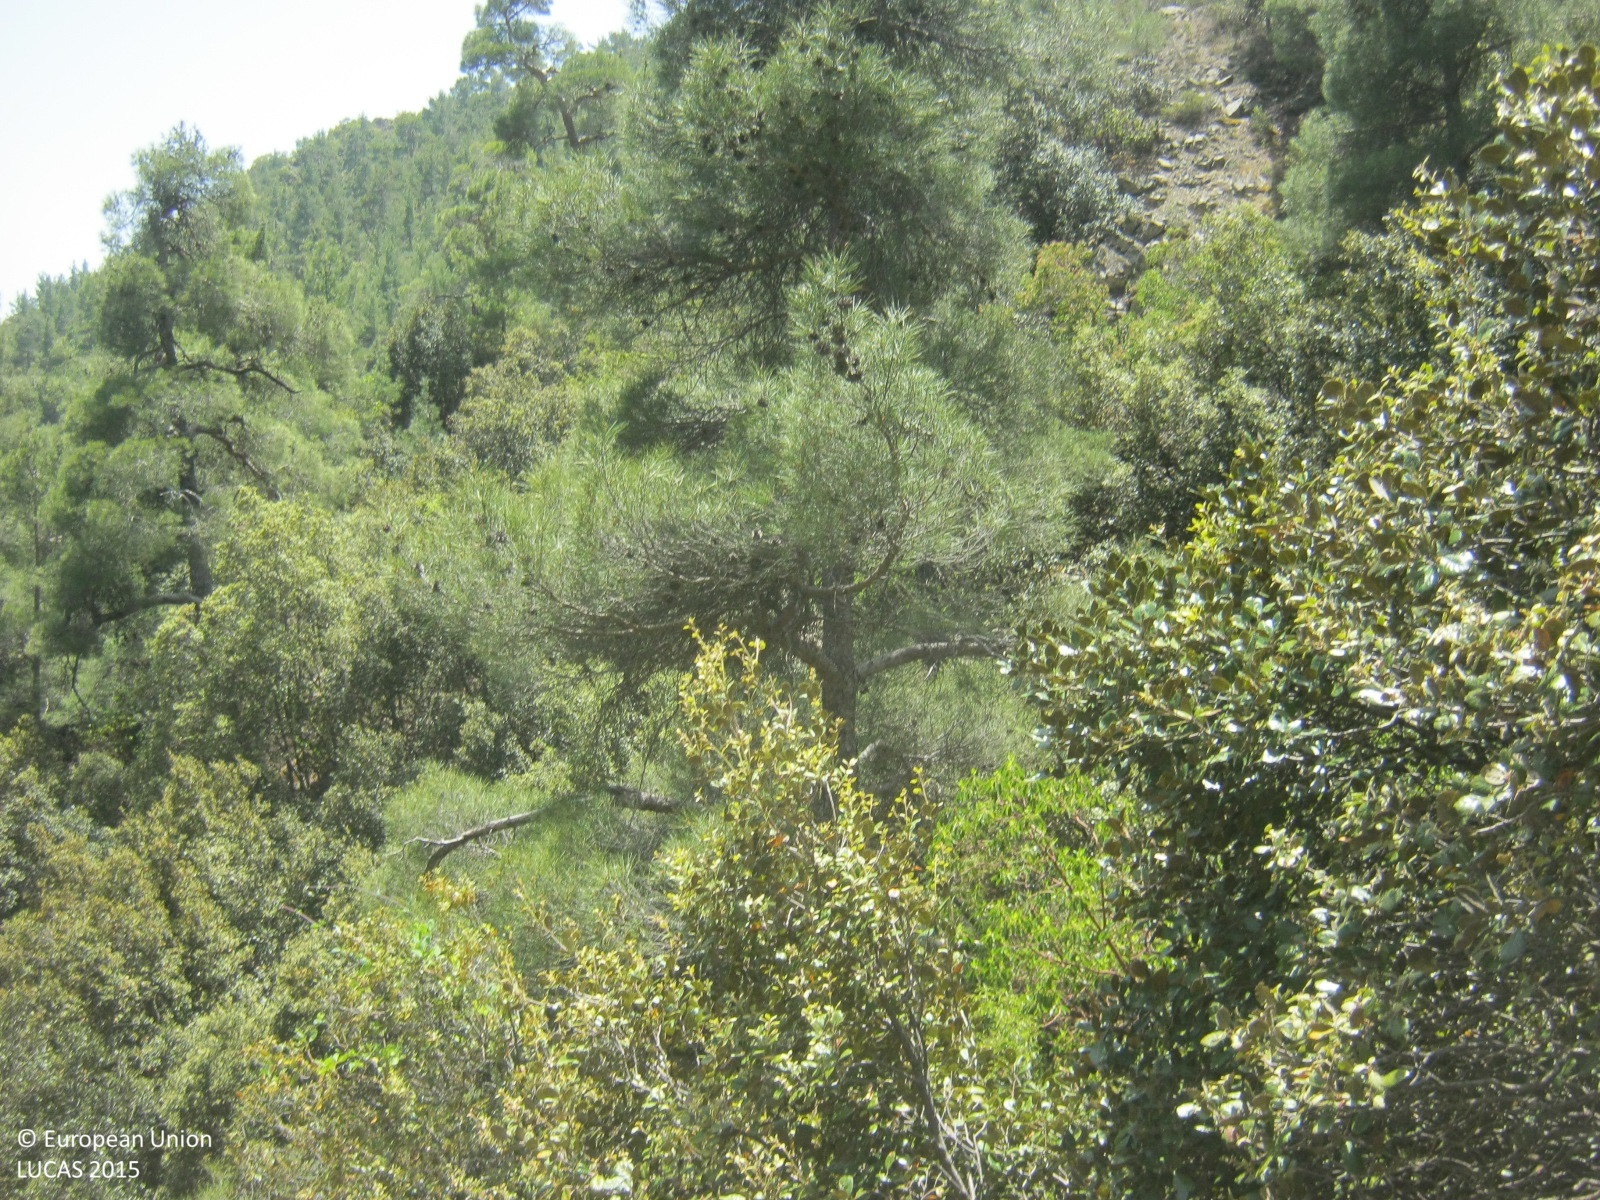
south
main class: Woodland
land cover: Pine dominated mixed woodland
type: coniferous forest of the mediterranean region
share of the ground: 50 - 75 %
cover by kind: coniferous forest trees 50 %, broadleaved forest trees 25 %, shrubs 10 %, consolidated bare surface 10 %, unconsolidated bare surface 5 %
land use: Forestry
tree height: > 5 m
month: May
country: CY
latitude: 34.9759
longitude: 32.8749
